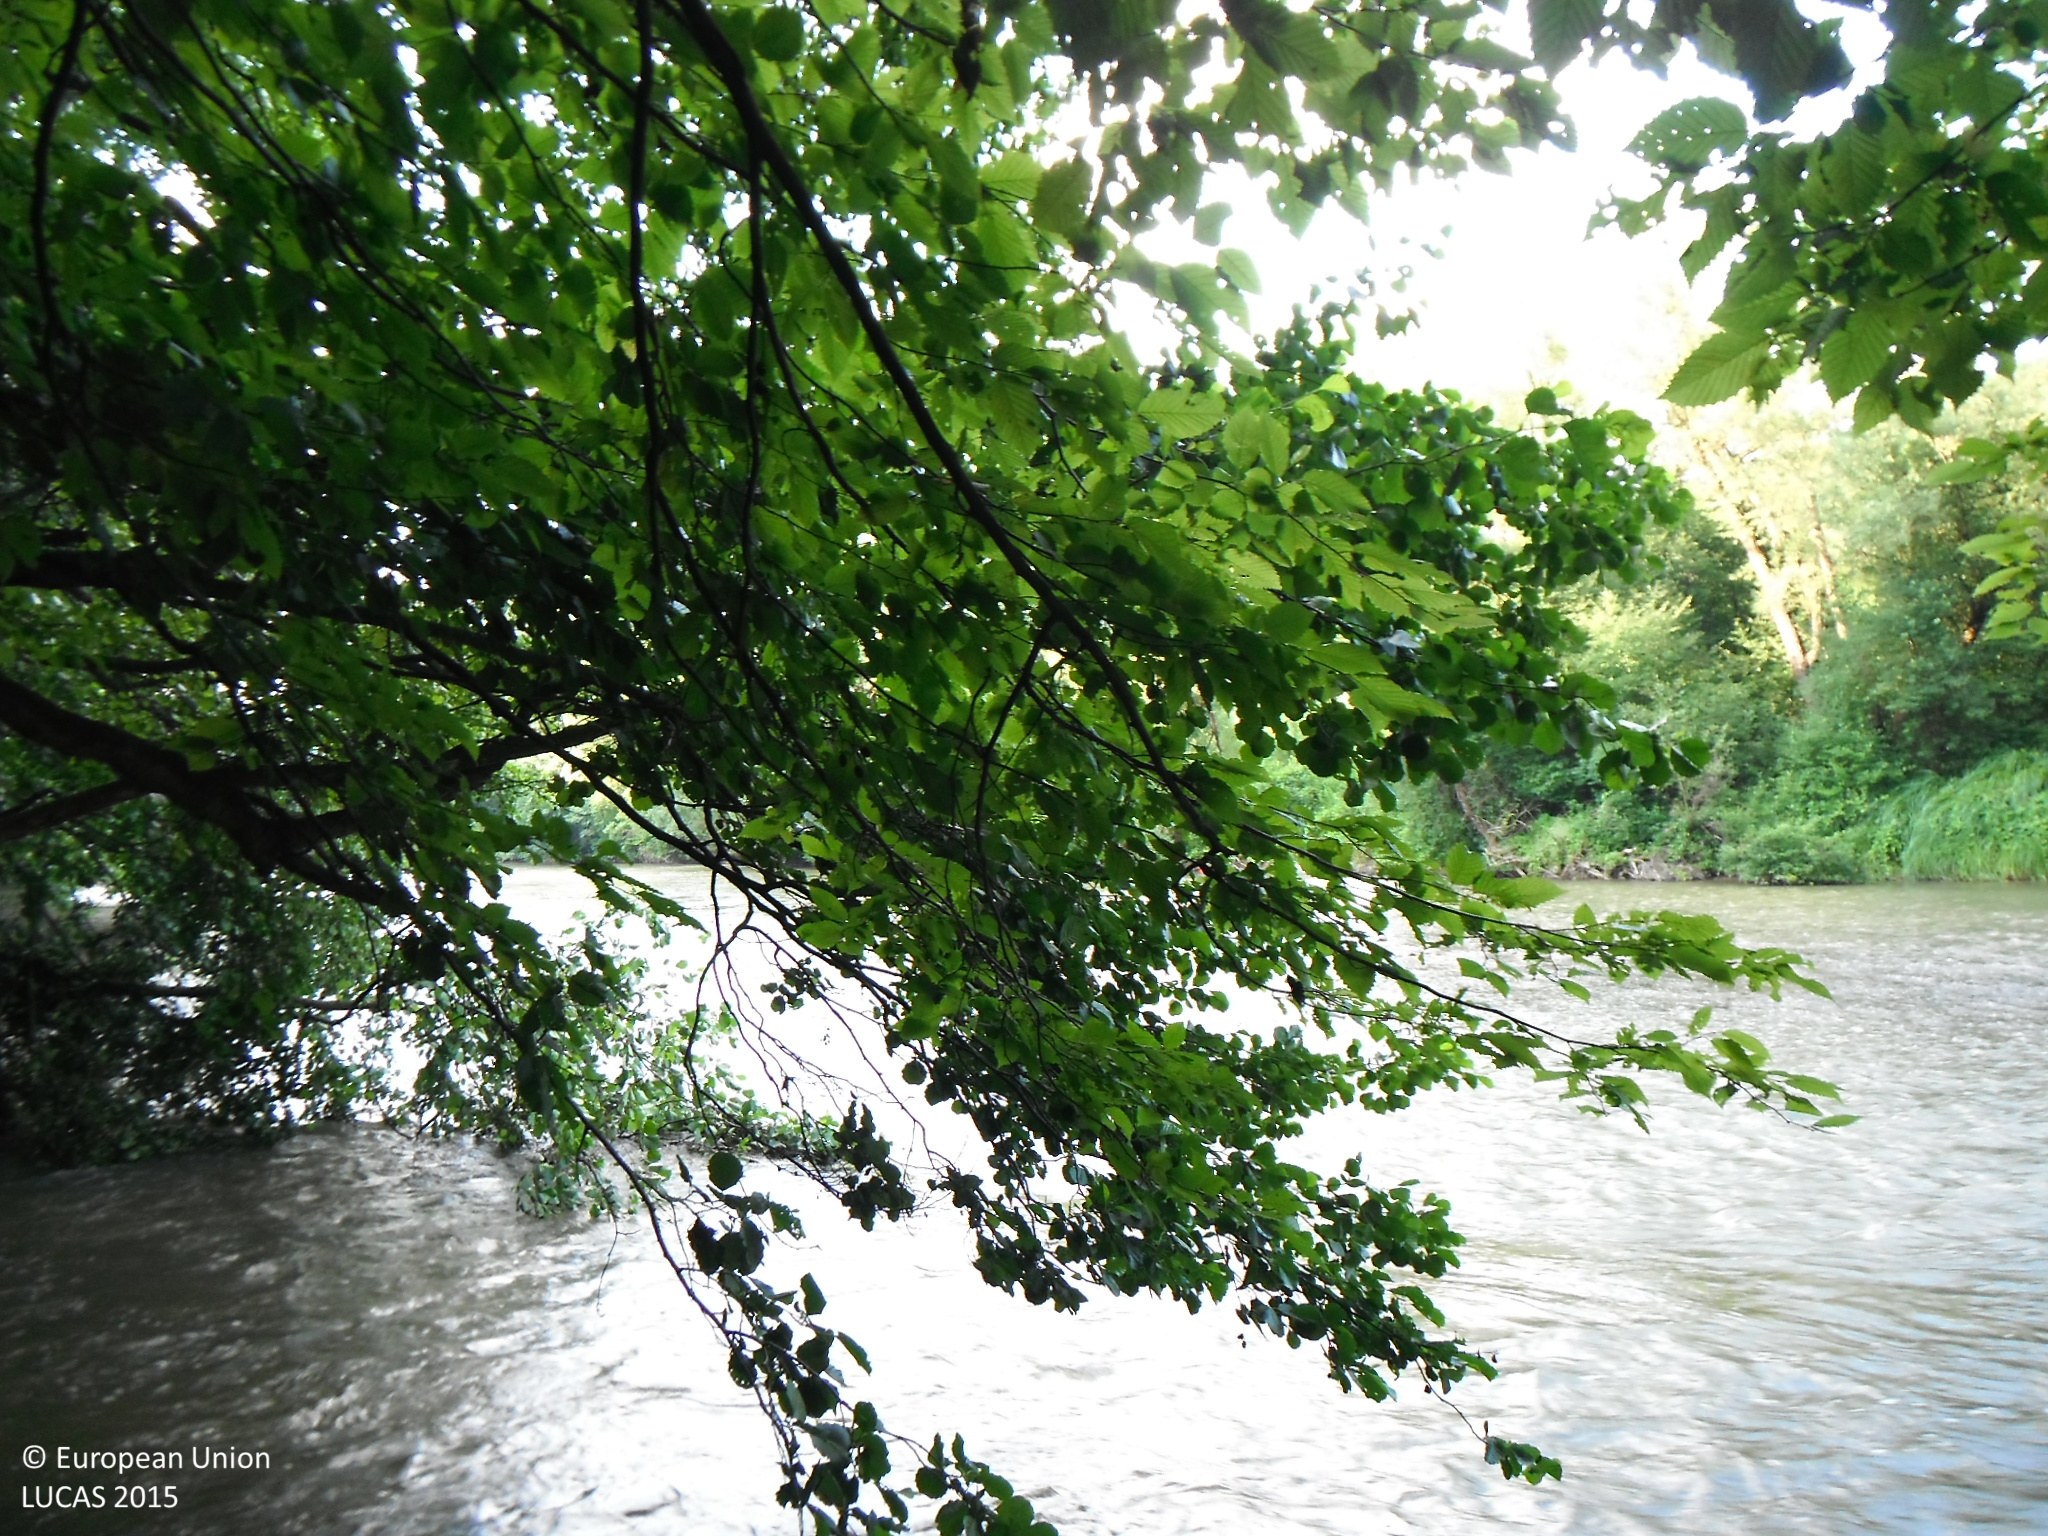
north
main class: Woodland
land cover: Broadleaved woodland
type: mesophytic deciduous forest
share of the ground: > 75 %
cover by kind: broadleaved forest trees 100 %
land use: Semi-natural and natural areas not in use
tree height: > 5 m
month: July
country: SK
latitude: 48.7726
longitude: 21.2429
